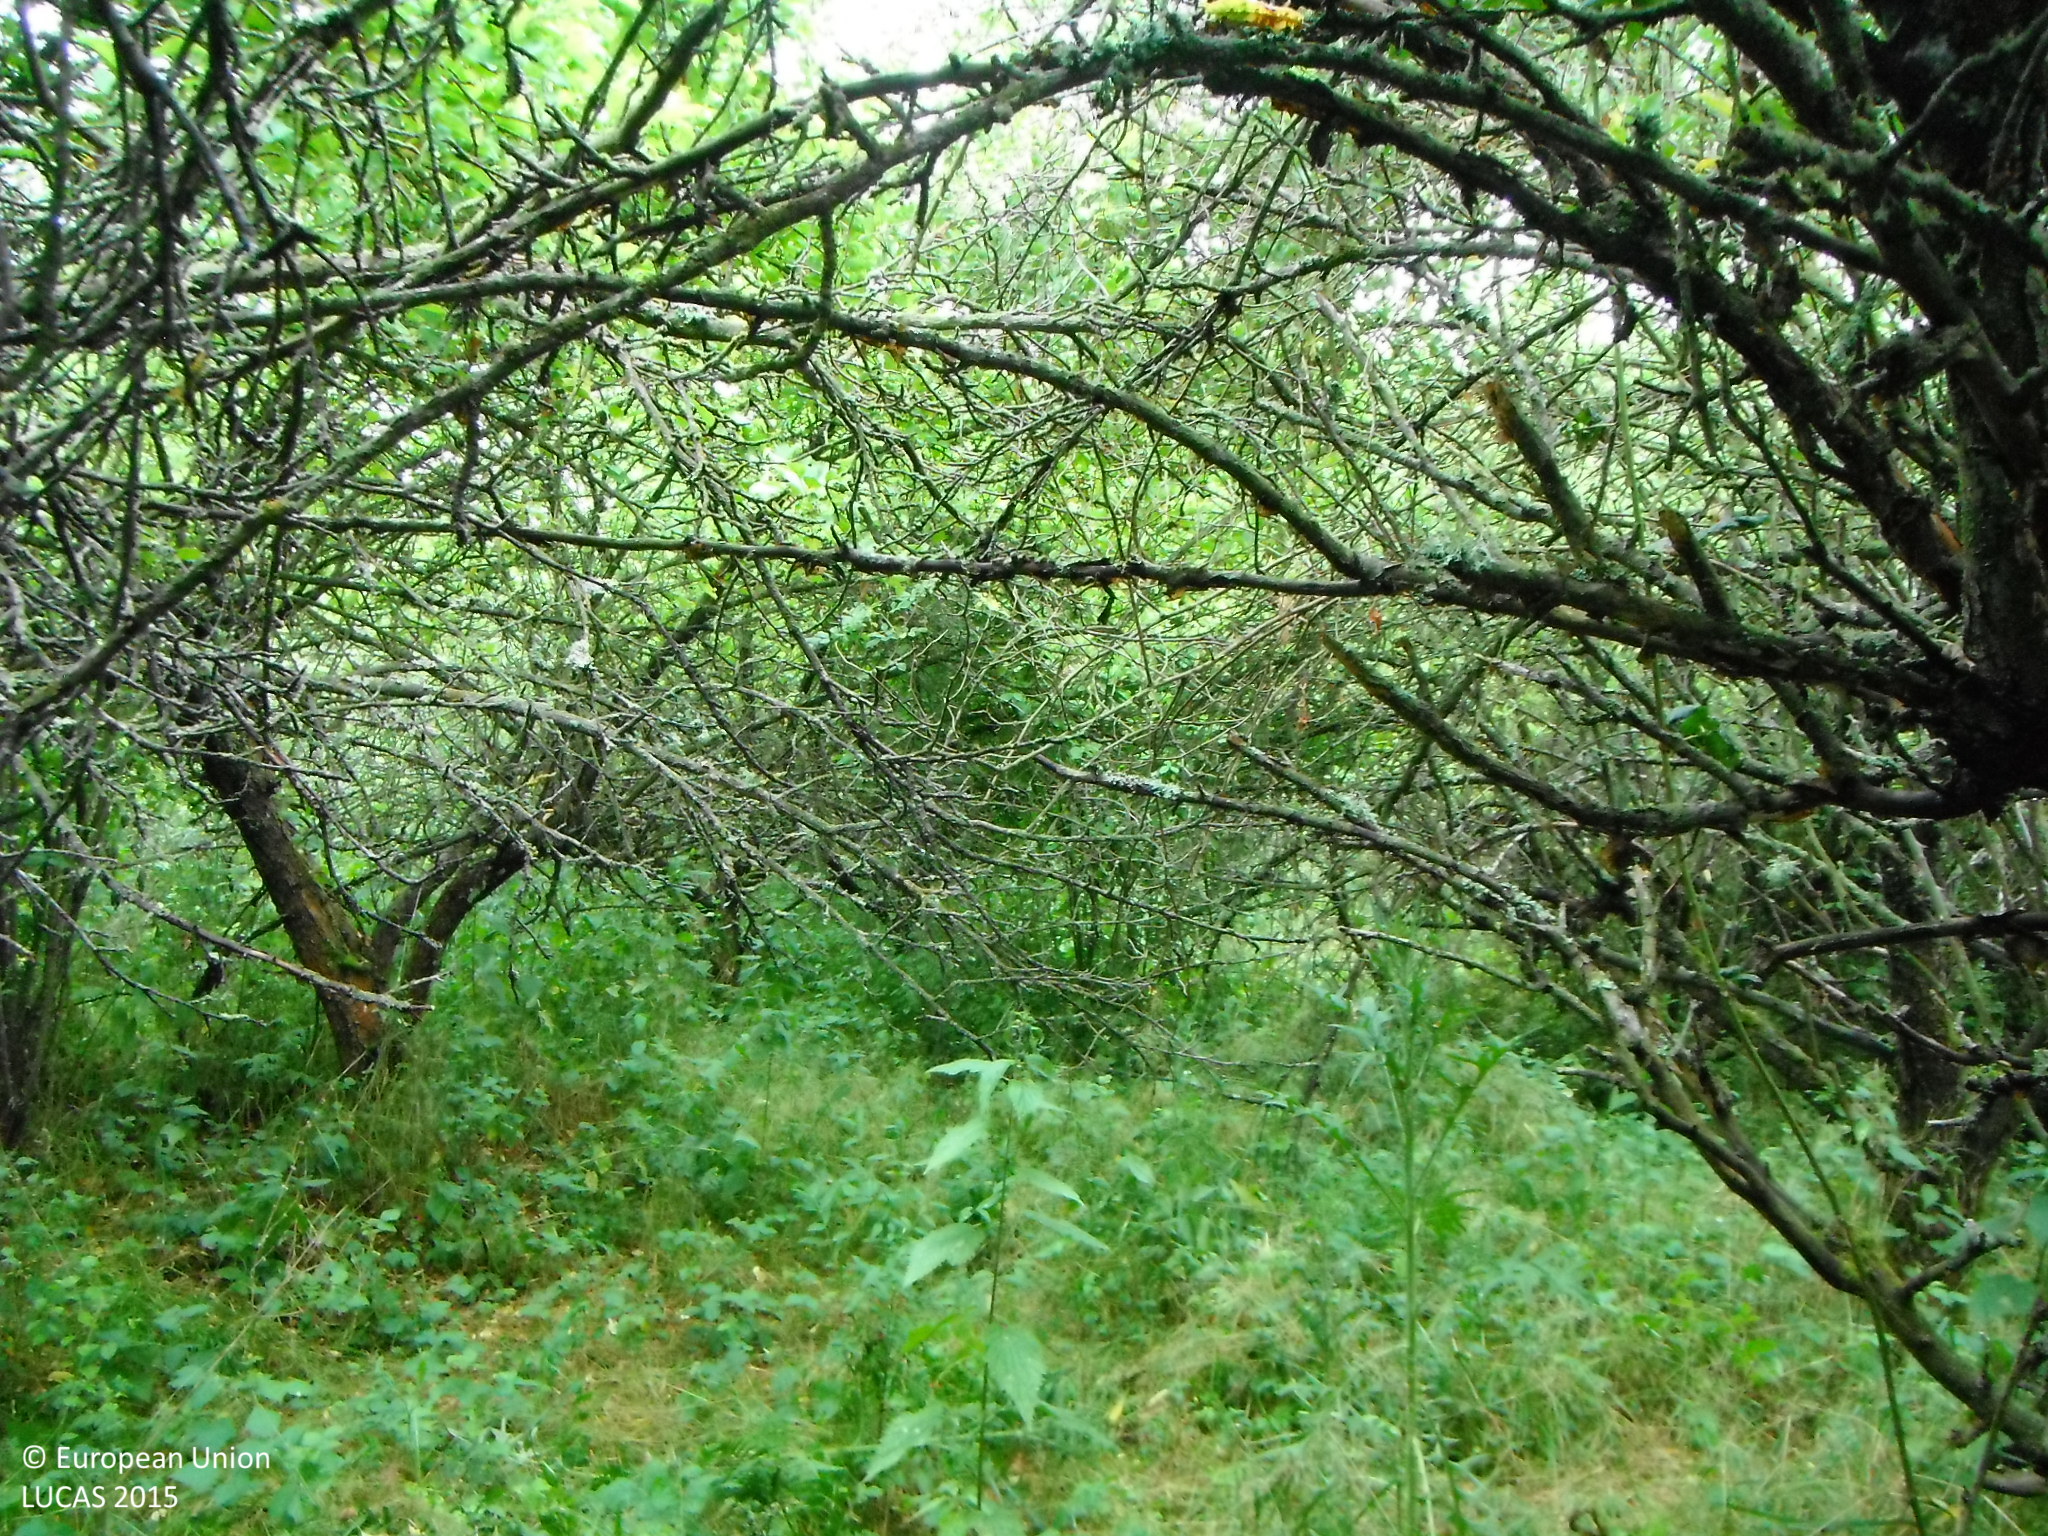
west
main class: Shrubland
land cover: Shrubland with sparse tree cover
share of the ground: > 75 %
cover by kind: shrubs 95 %, broadleaved forest trees 5 %
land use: Abandoned areas
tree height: > 5 m
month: June
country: SK
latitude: 48.1323
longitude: 18.9277
